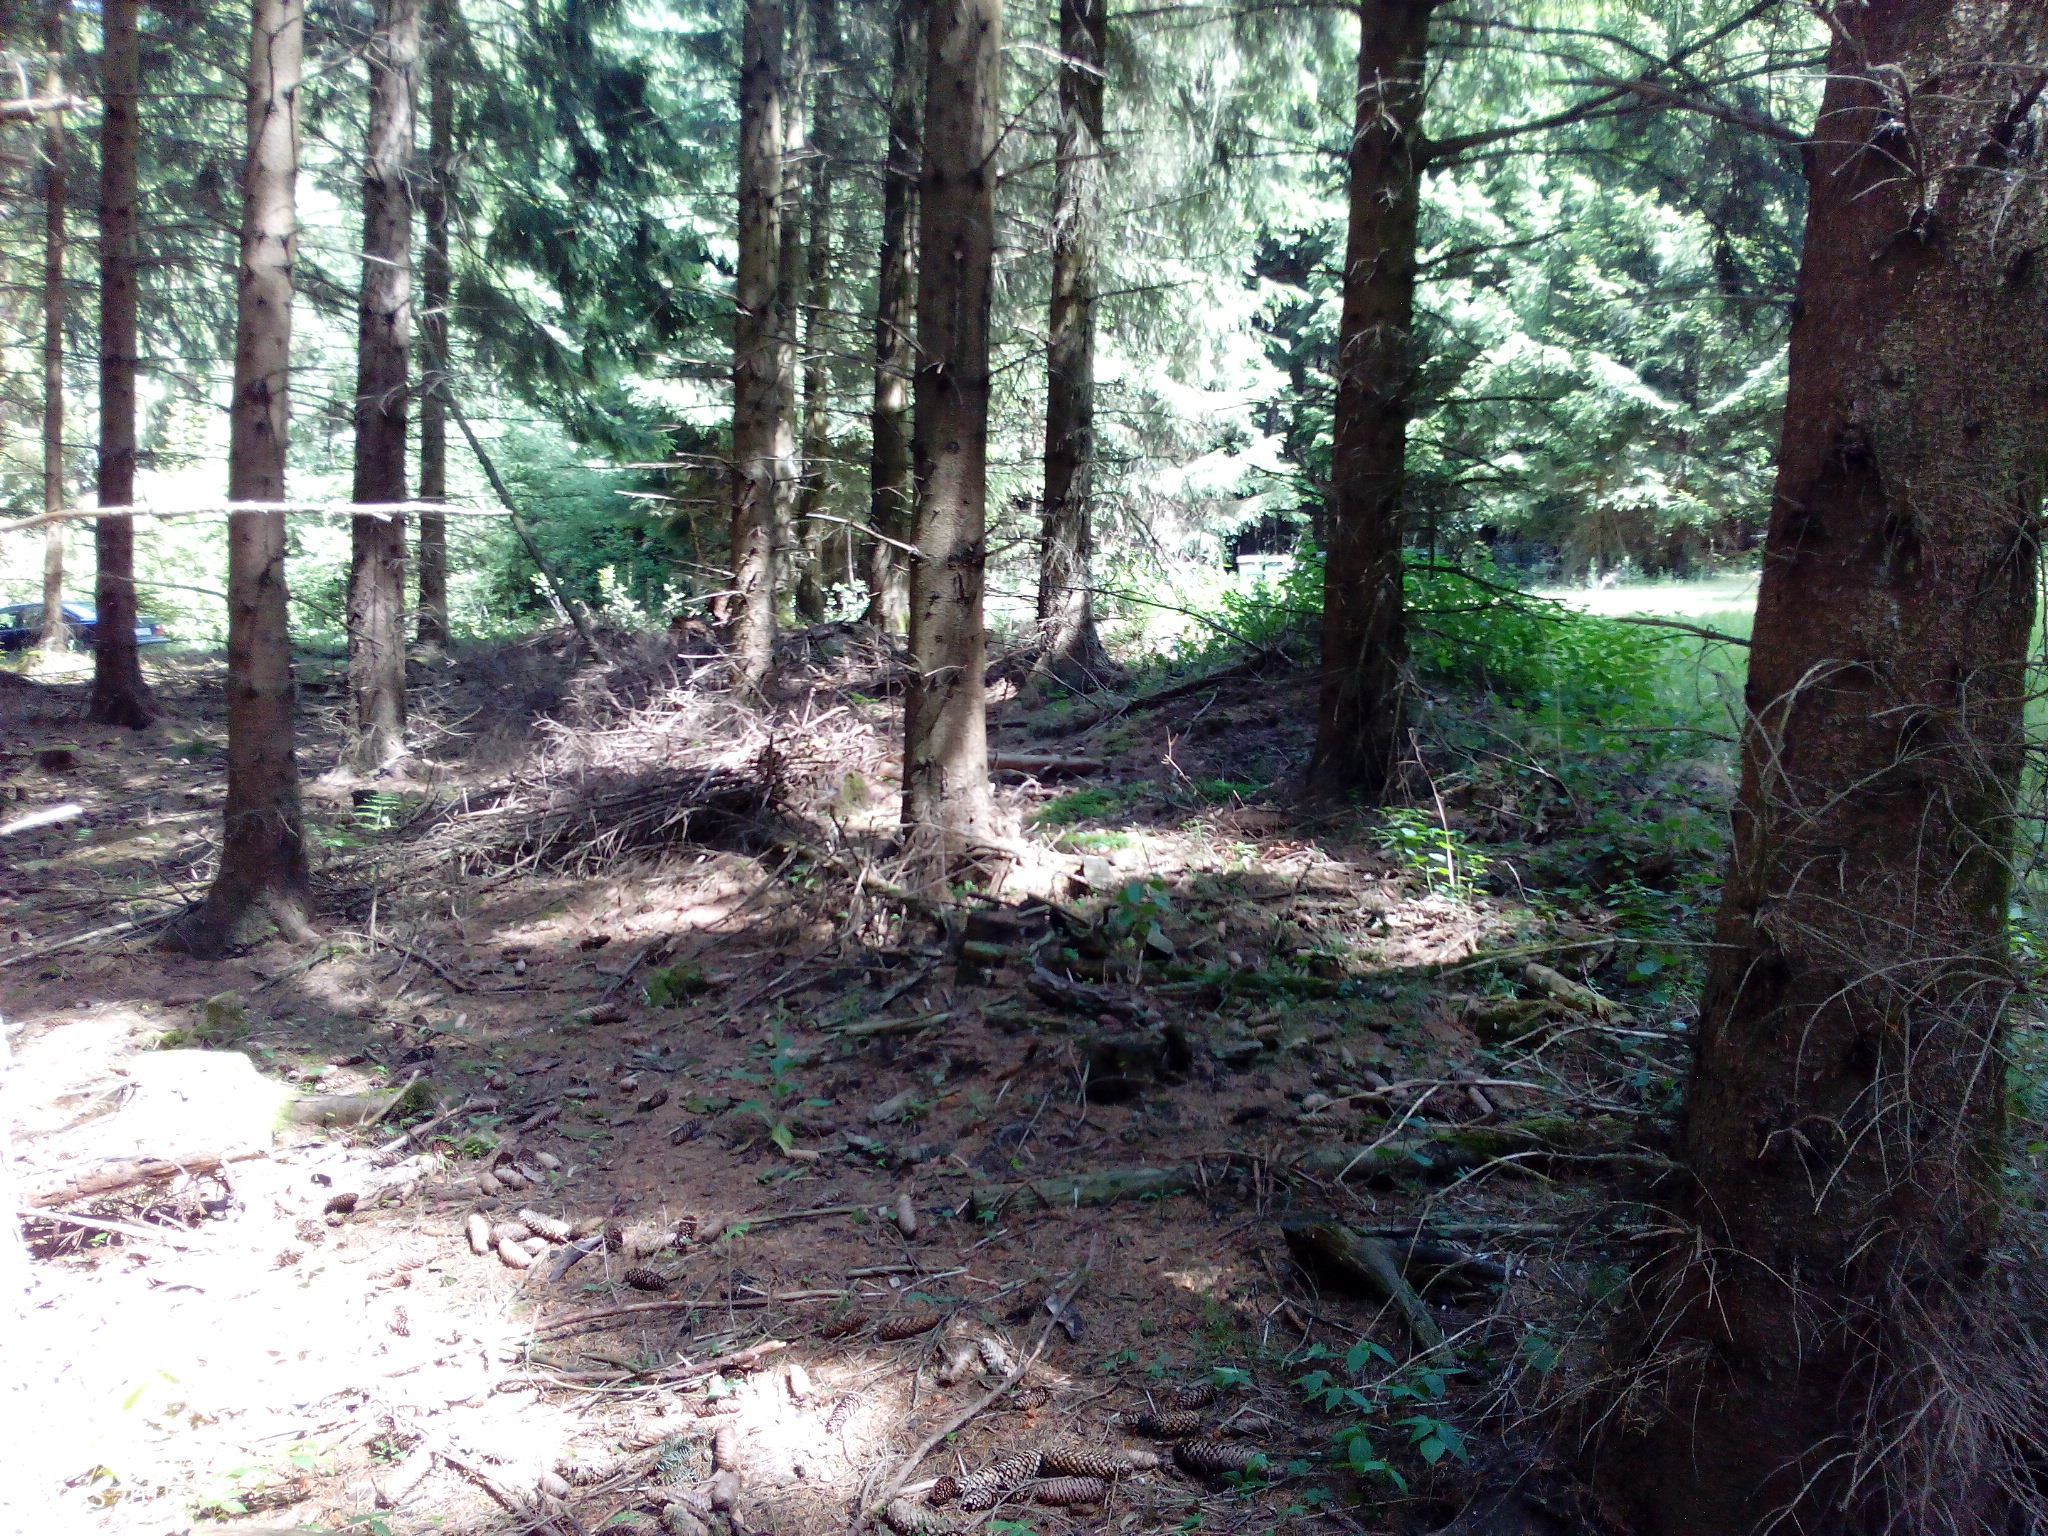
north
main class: Woodland
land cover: Spruce dominated coniferous woodland
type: hemiboreal forest and nemoral coniferous forest and mixed broadleaved-coniferous forest
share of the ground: > 75 %
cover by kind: coniferous forest trees 100 %
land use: Forestry
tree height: > 5 m
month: June
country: DE
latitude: 51.4869
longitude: 8.4882
